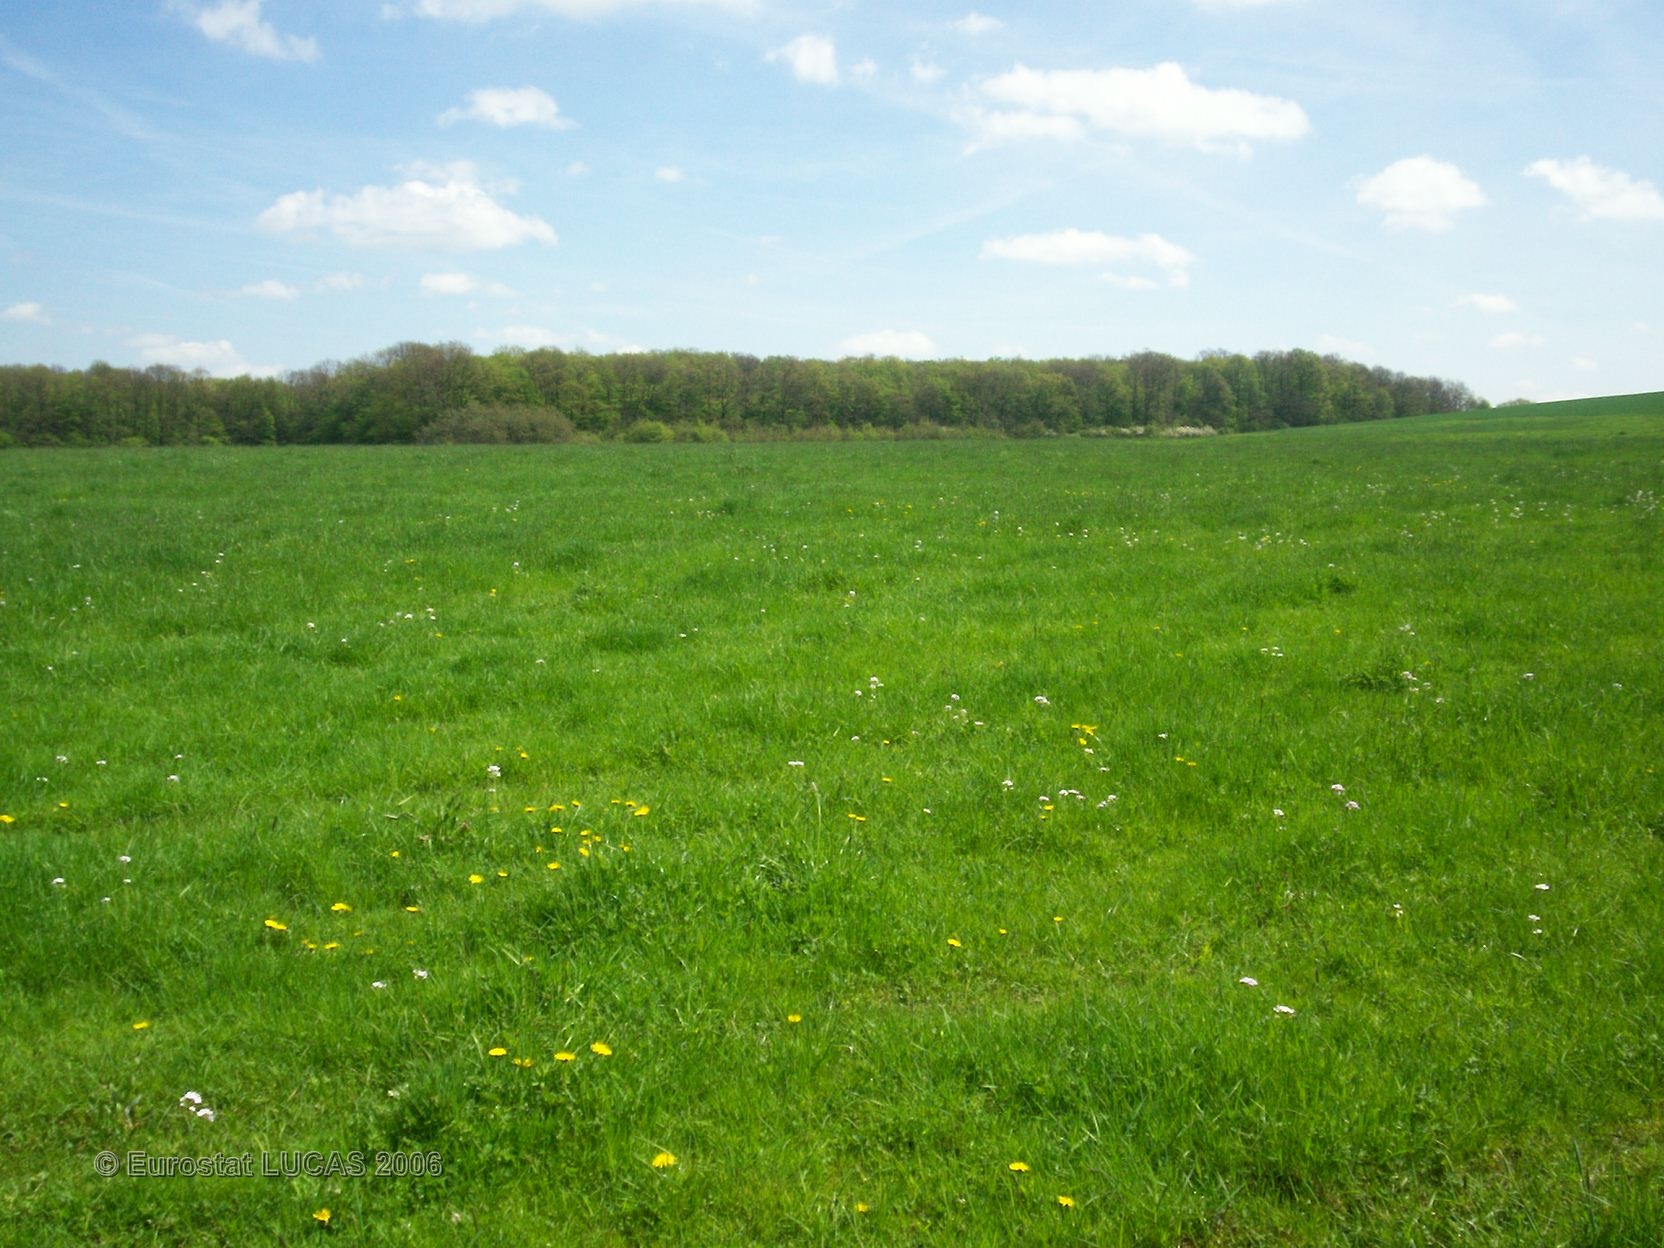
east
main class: Grassland
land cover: Grassland without tree/shrub cover
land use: Agriculture (excluding fallow land and kitchen gardens)
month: May
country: FR
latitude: 49.0941
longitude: 6.7546
